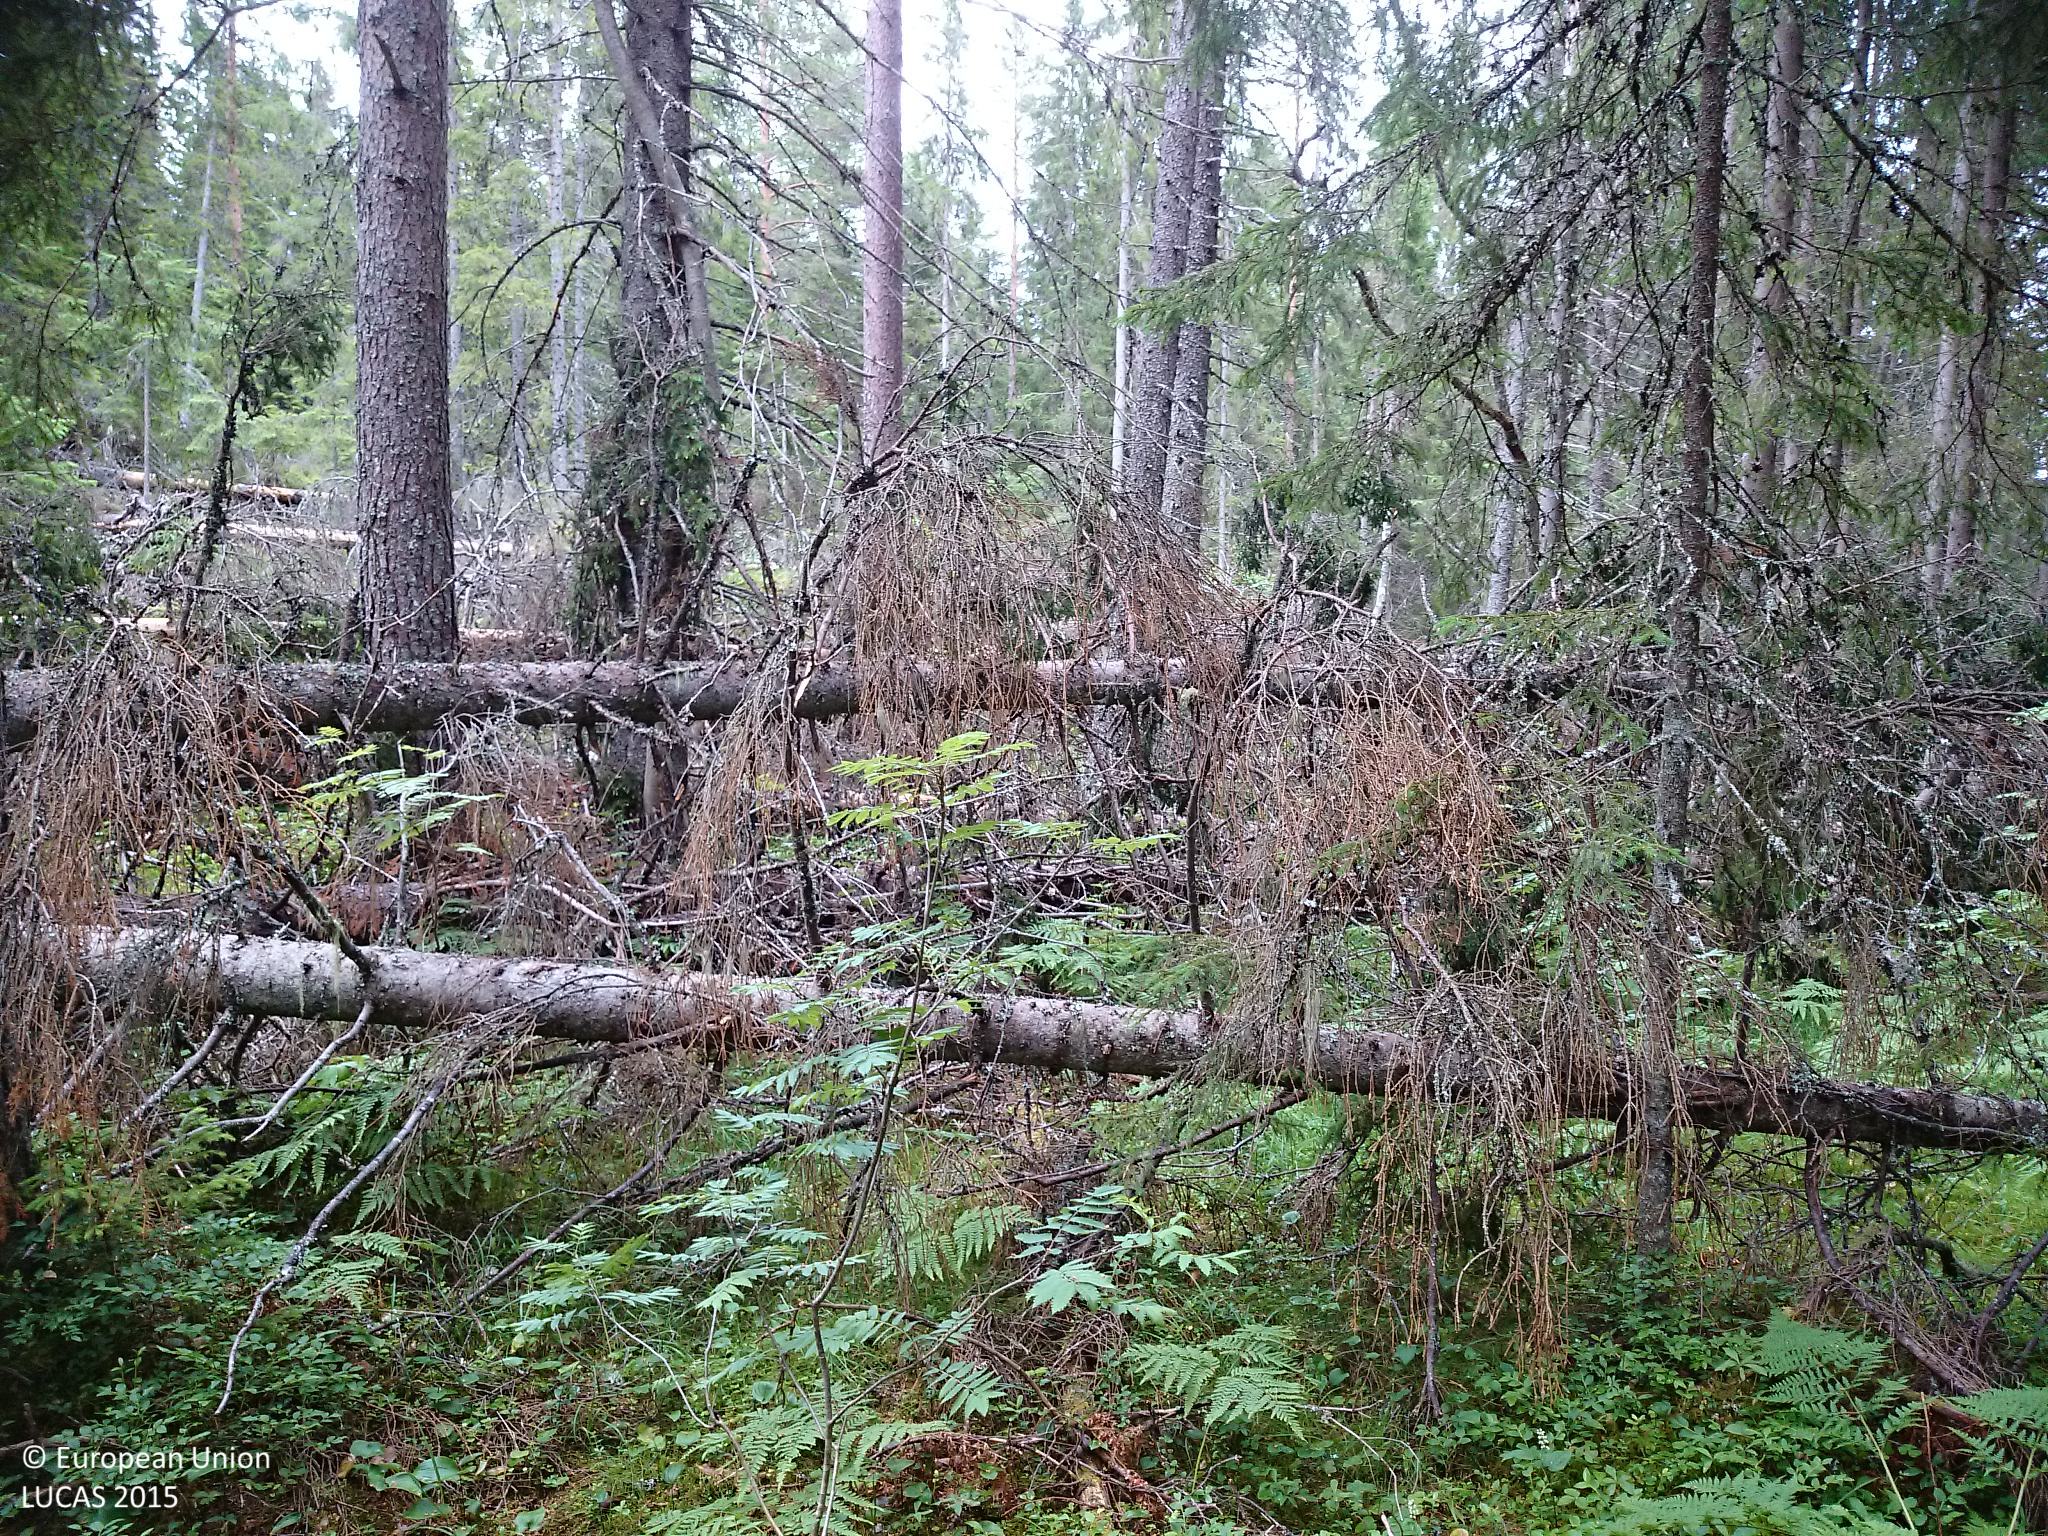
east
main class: Woodland
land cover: Spruce dominated coniferous woodland
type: boreal forest
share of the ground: 50 - 75 %
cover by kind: coniferous forest trees 60 %, shrubs 20 %, lichens and mosses 20 %
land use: Forestry
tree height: > 5 m
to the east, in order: Spruce dominated coniferous woodland
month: July
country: SE
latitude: 62.5184
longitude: 17.8088
